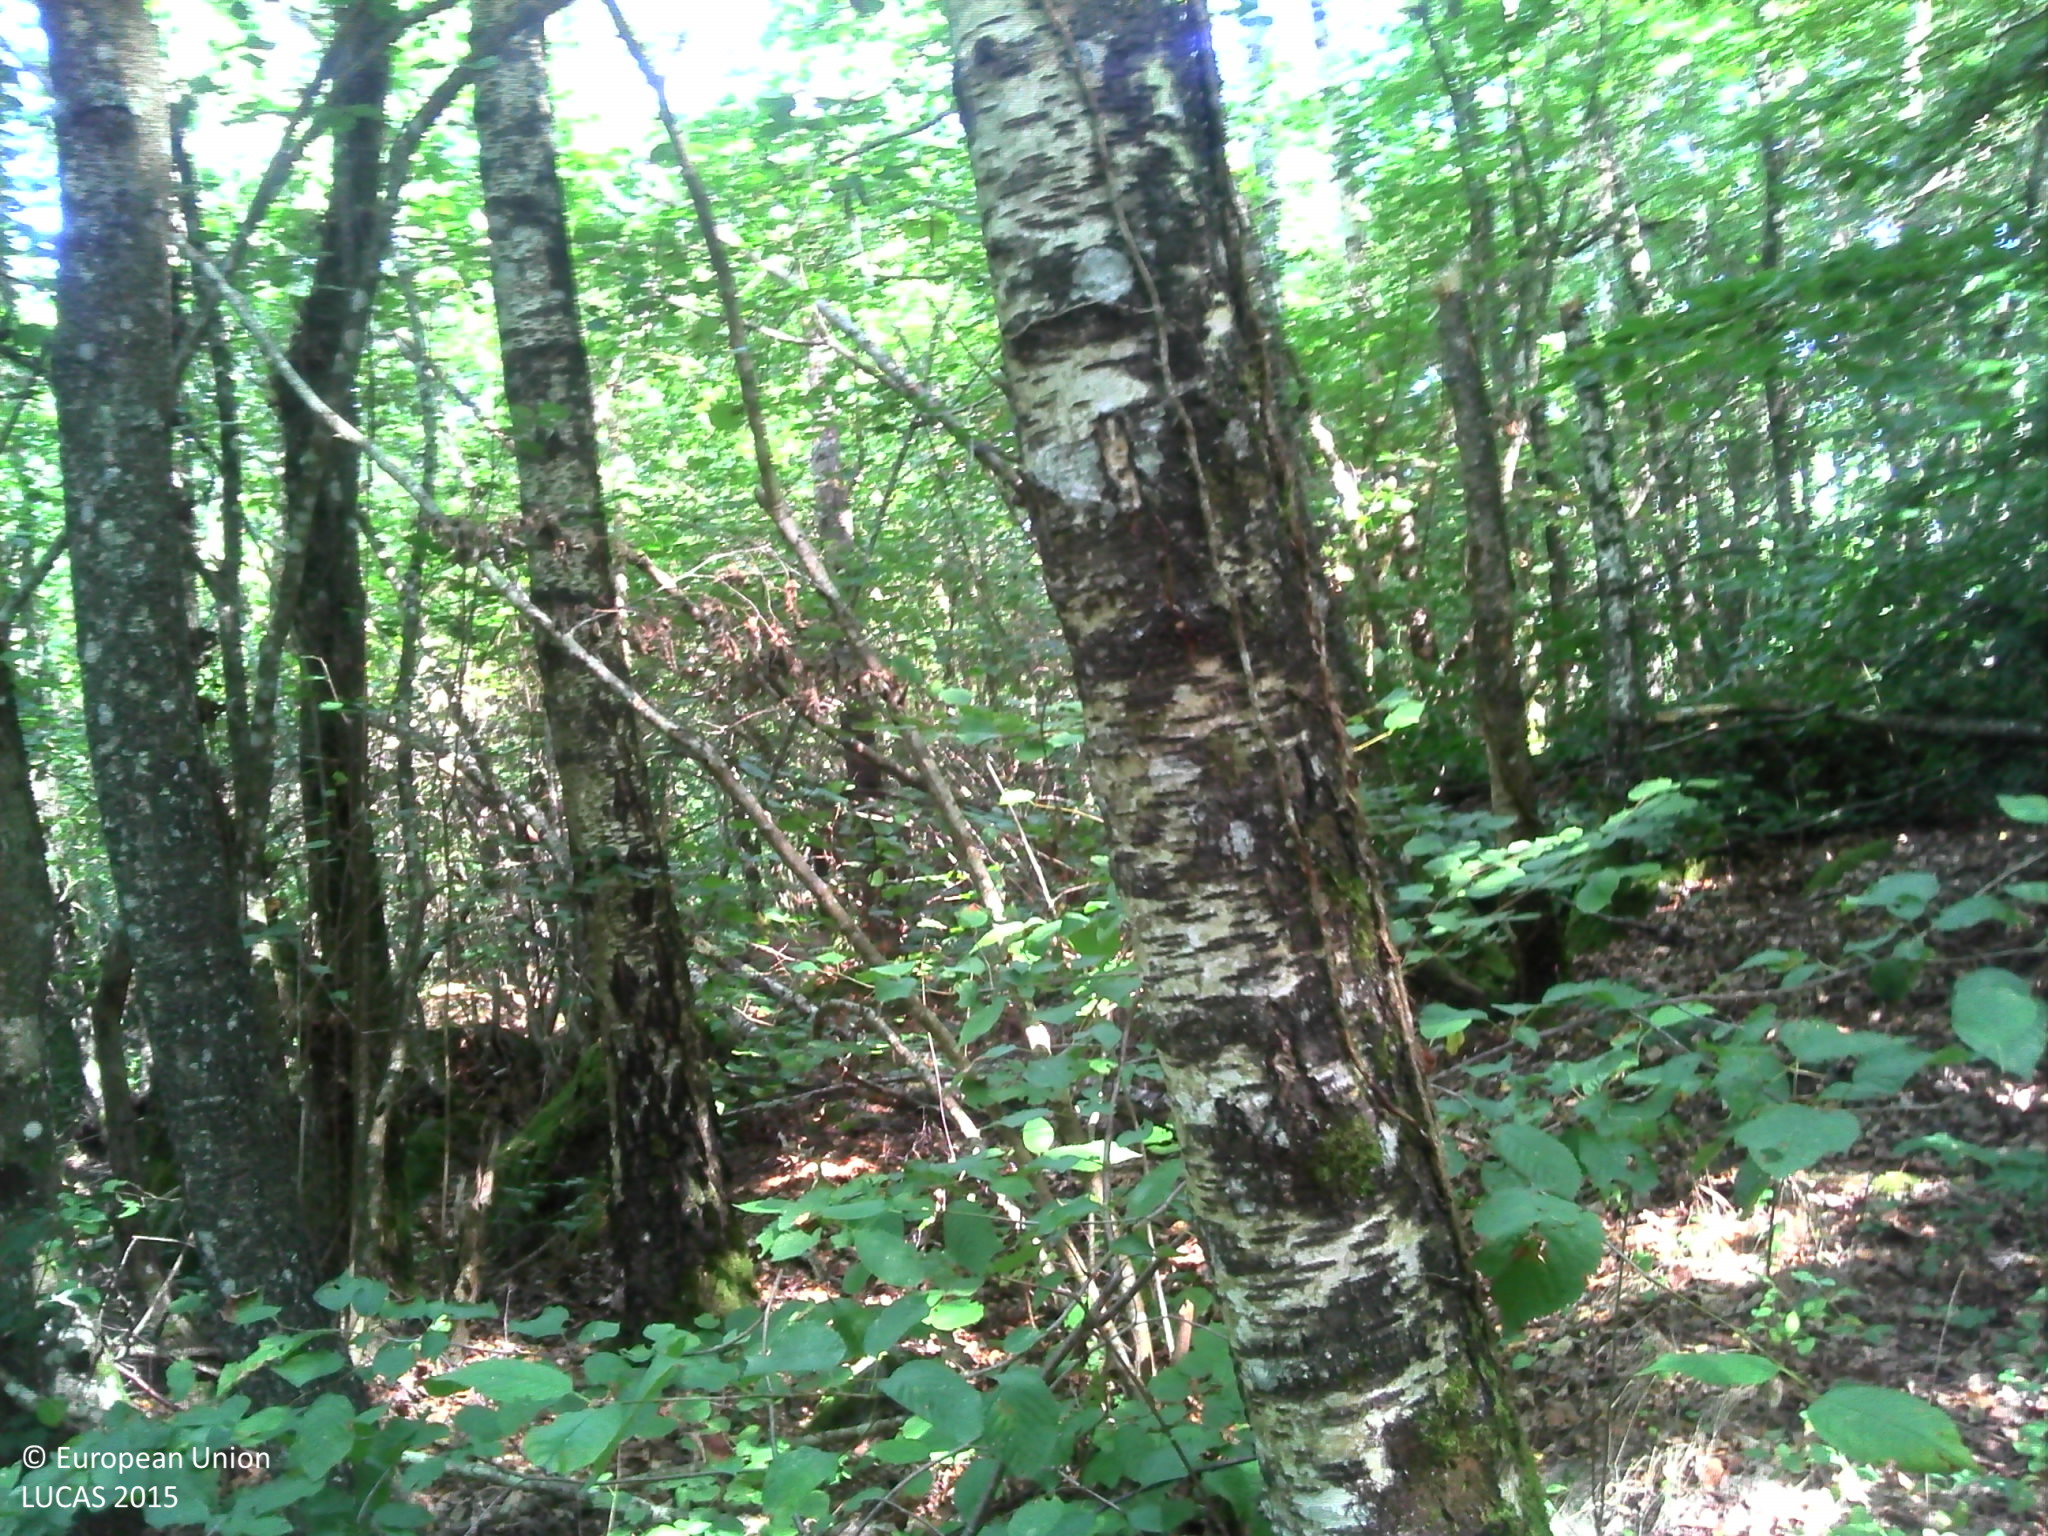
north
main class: Woodland
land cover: Broadleaved woodland
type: acidophilous oak and oak-birch forest
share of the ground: > 75 %
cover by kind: broadleaved forest trees 65 %, shrubs 10 %, herbaceous plants 10 %, consolidated bare surface 10 %, lichens and mosses 5 %
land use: Forestry
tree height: > 5 m
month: August
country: FR
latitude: 45.9501
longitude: 2.3460
